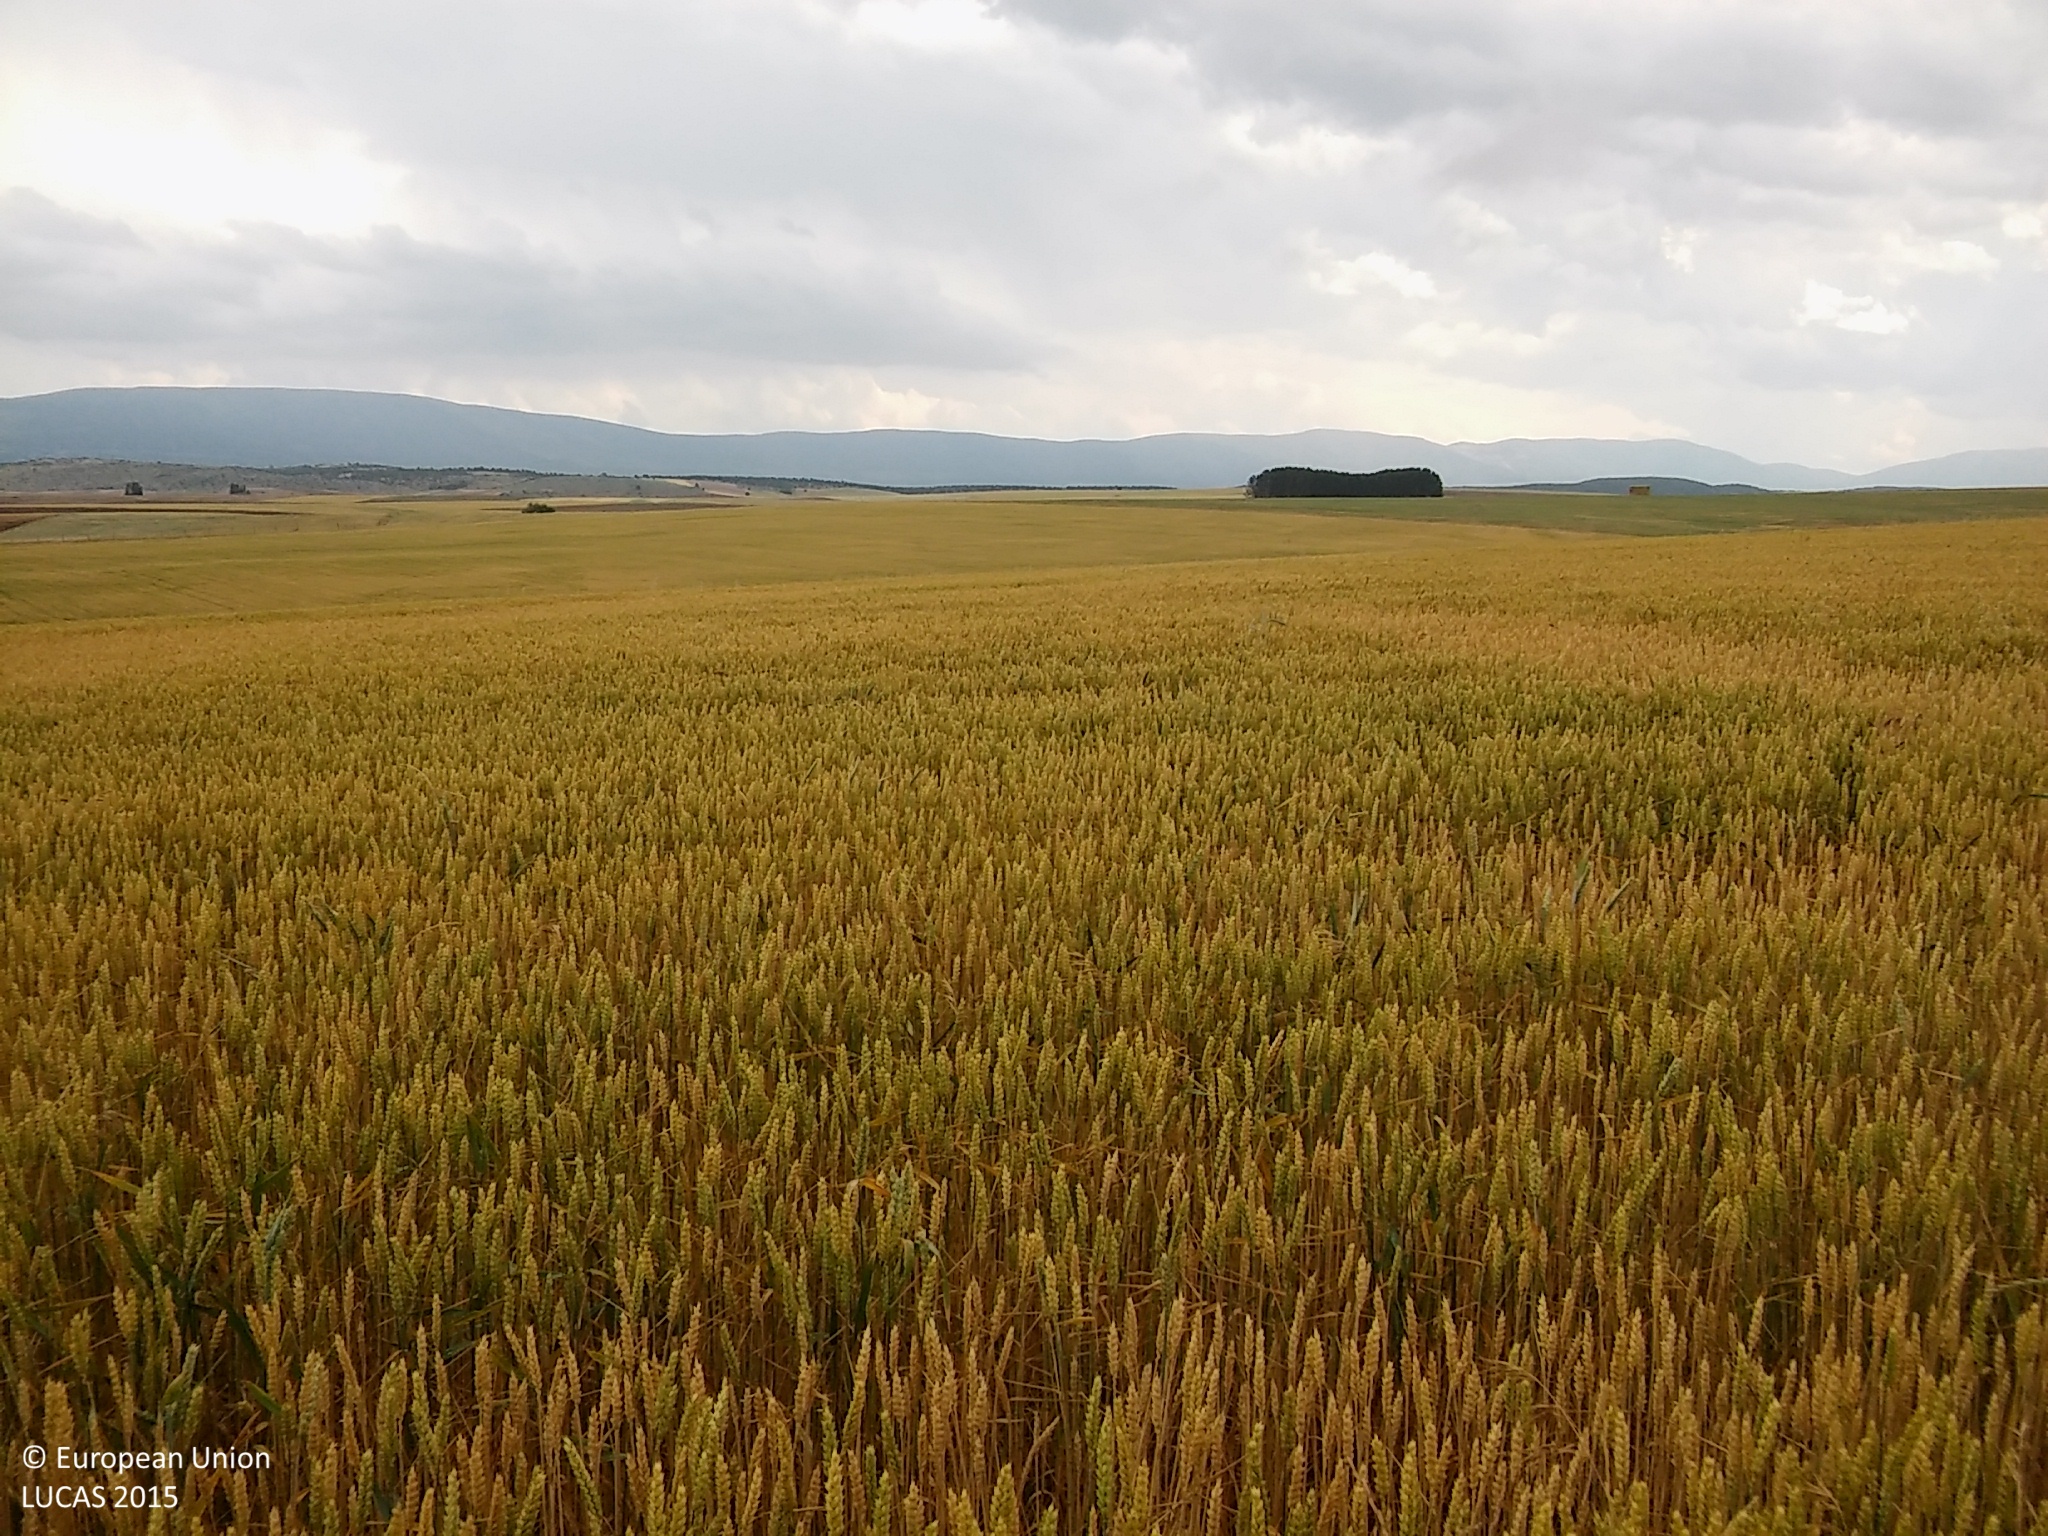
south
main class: Cropland
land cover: Common wheat
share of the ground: > 75 %
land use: Agriculture (excluding fallow land and kitchen gardens)
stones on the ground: 10 - 25 %
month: June
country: ES
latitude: 41.2233
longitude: -3.7062
